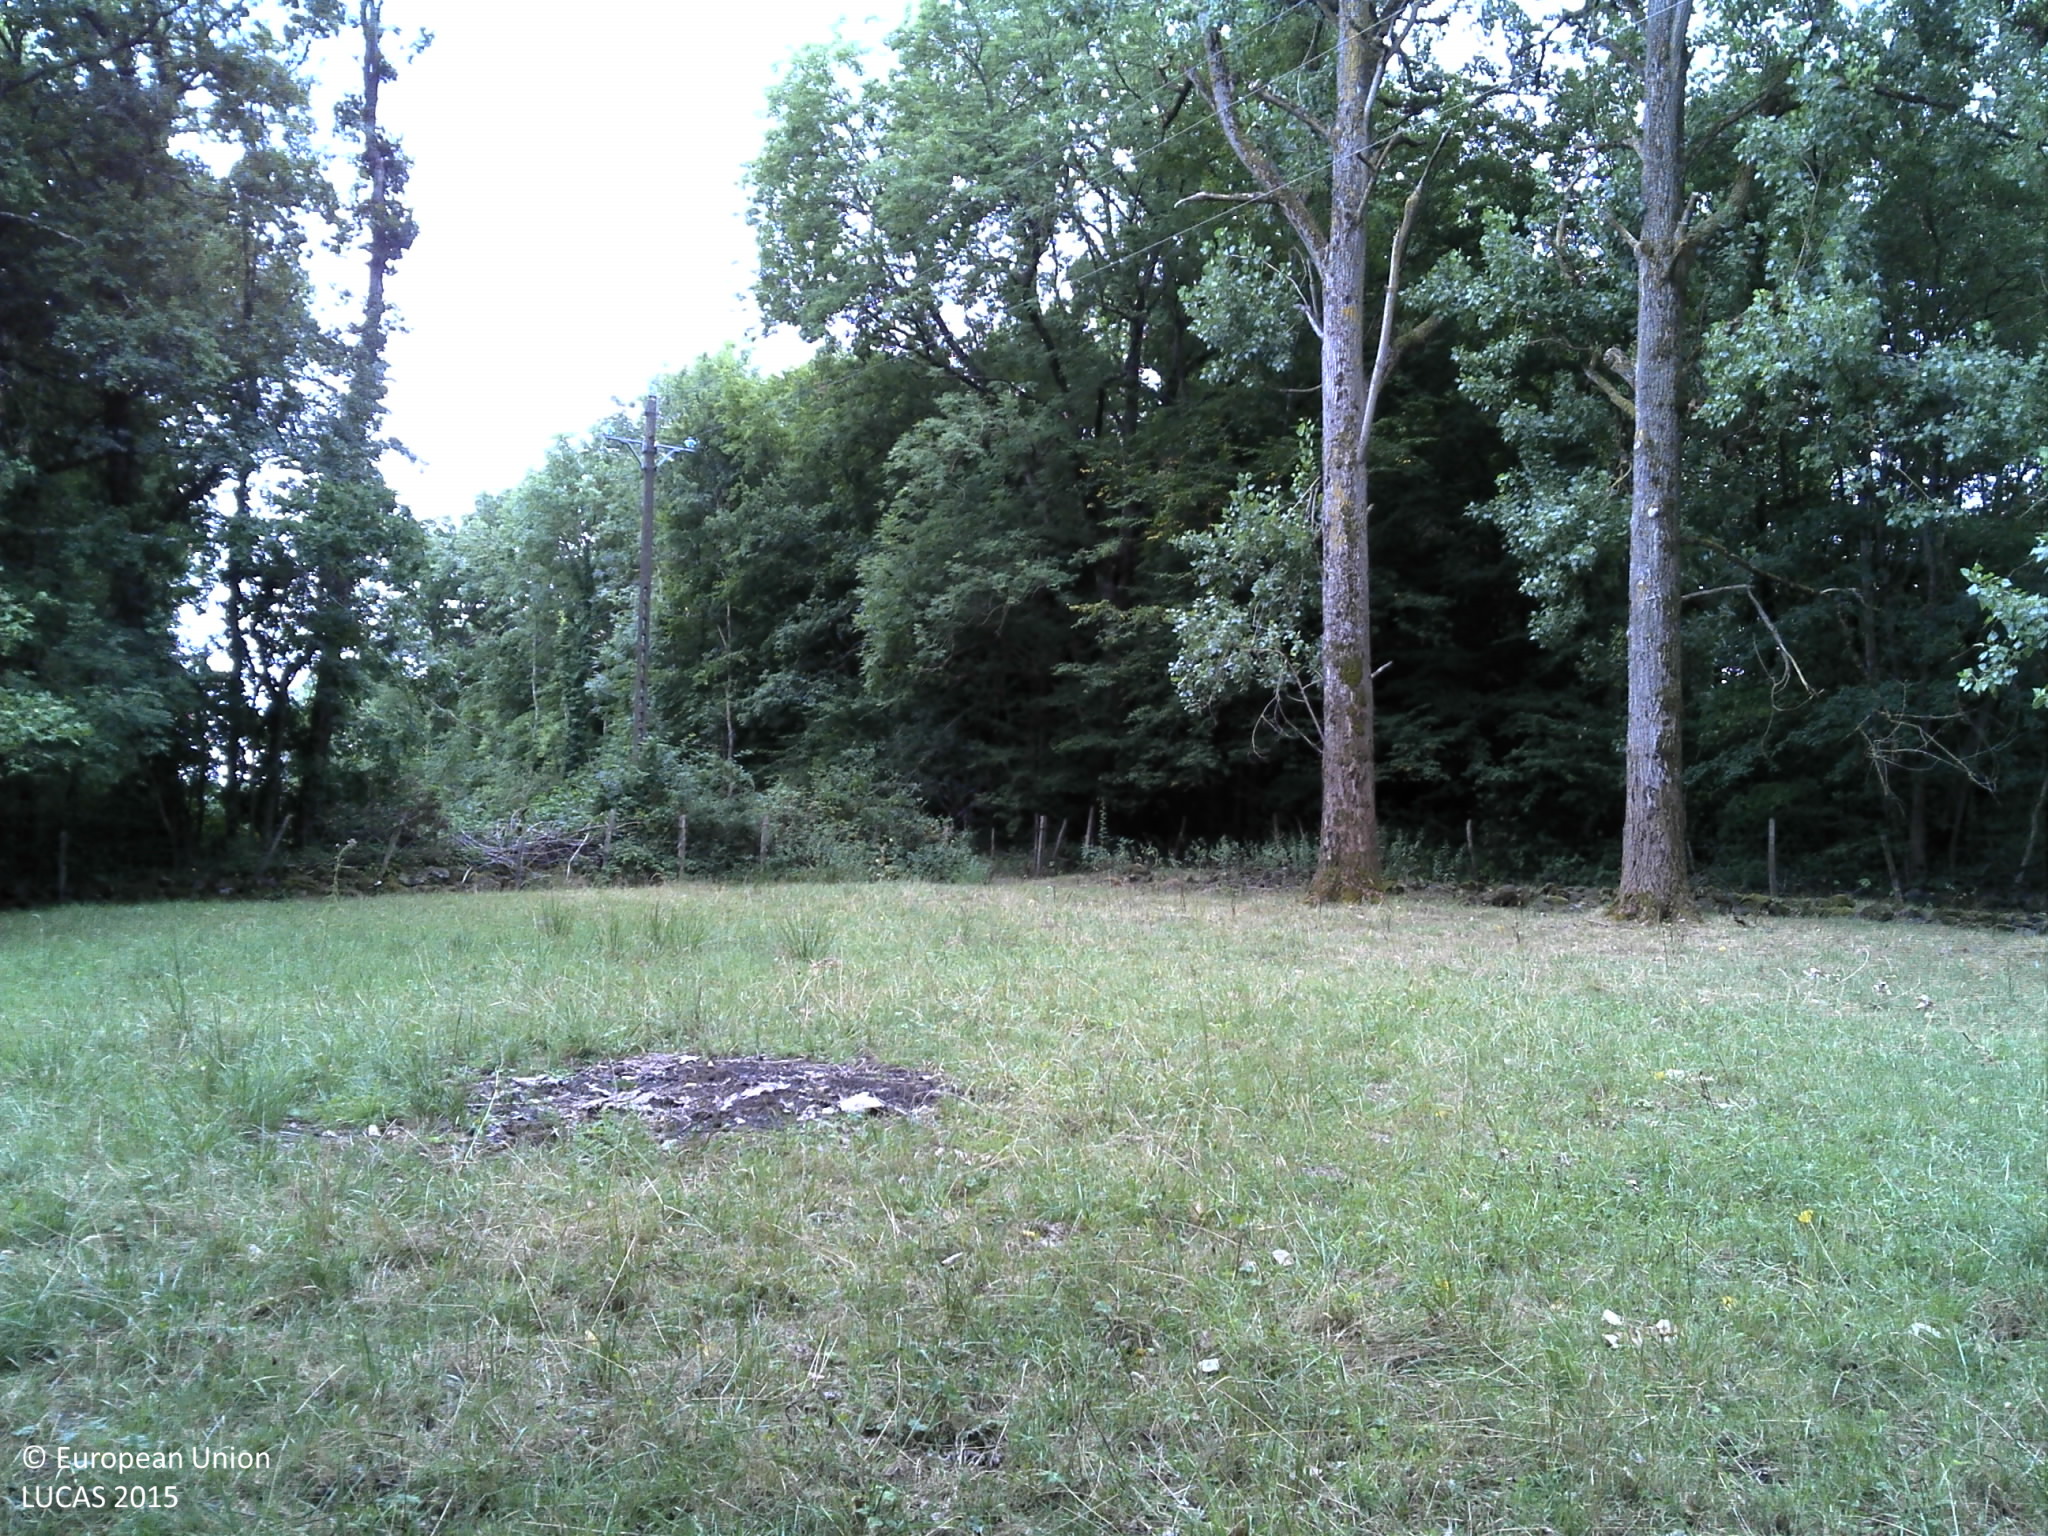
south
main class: Woodland
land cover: Broadleaved woodland
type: mesophytic deciduous forest
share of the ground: 25 - 50 %
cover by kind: herbaceous plants 50 %, broadleaved forest trees 40 %, shrubs 10 %
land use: Forestry
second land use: Agriculture (excluding fallow land and kitchen gardens)
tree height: > 5 m
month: July
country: FR
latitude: 45.6736
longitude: 3.3383
